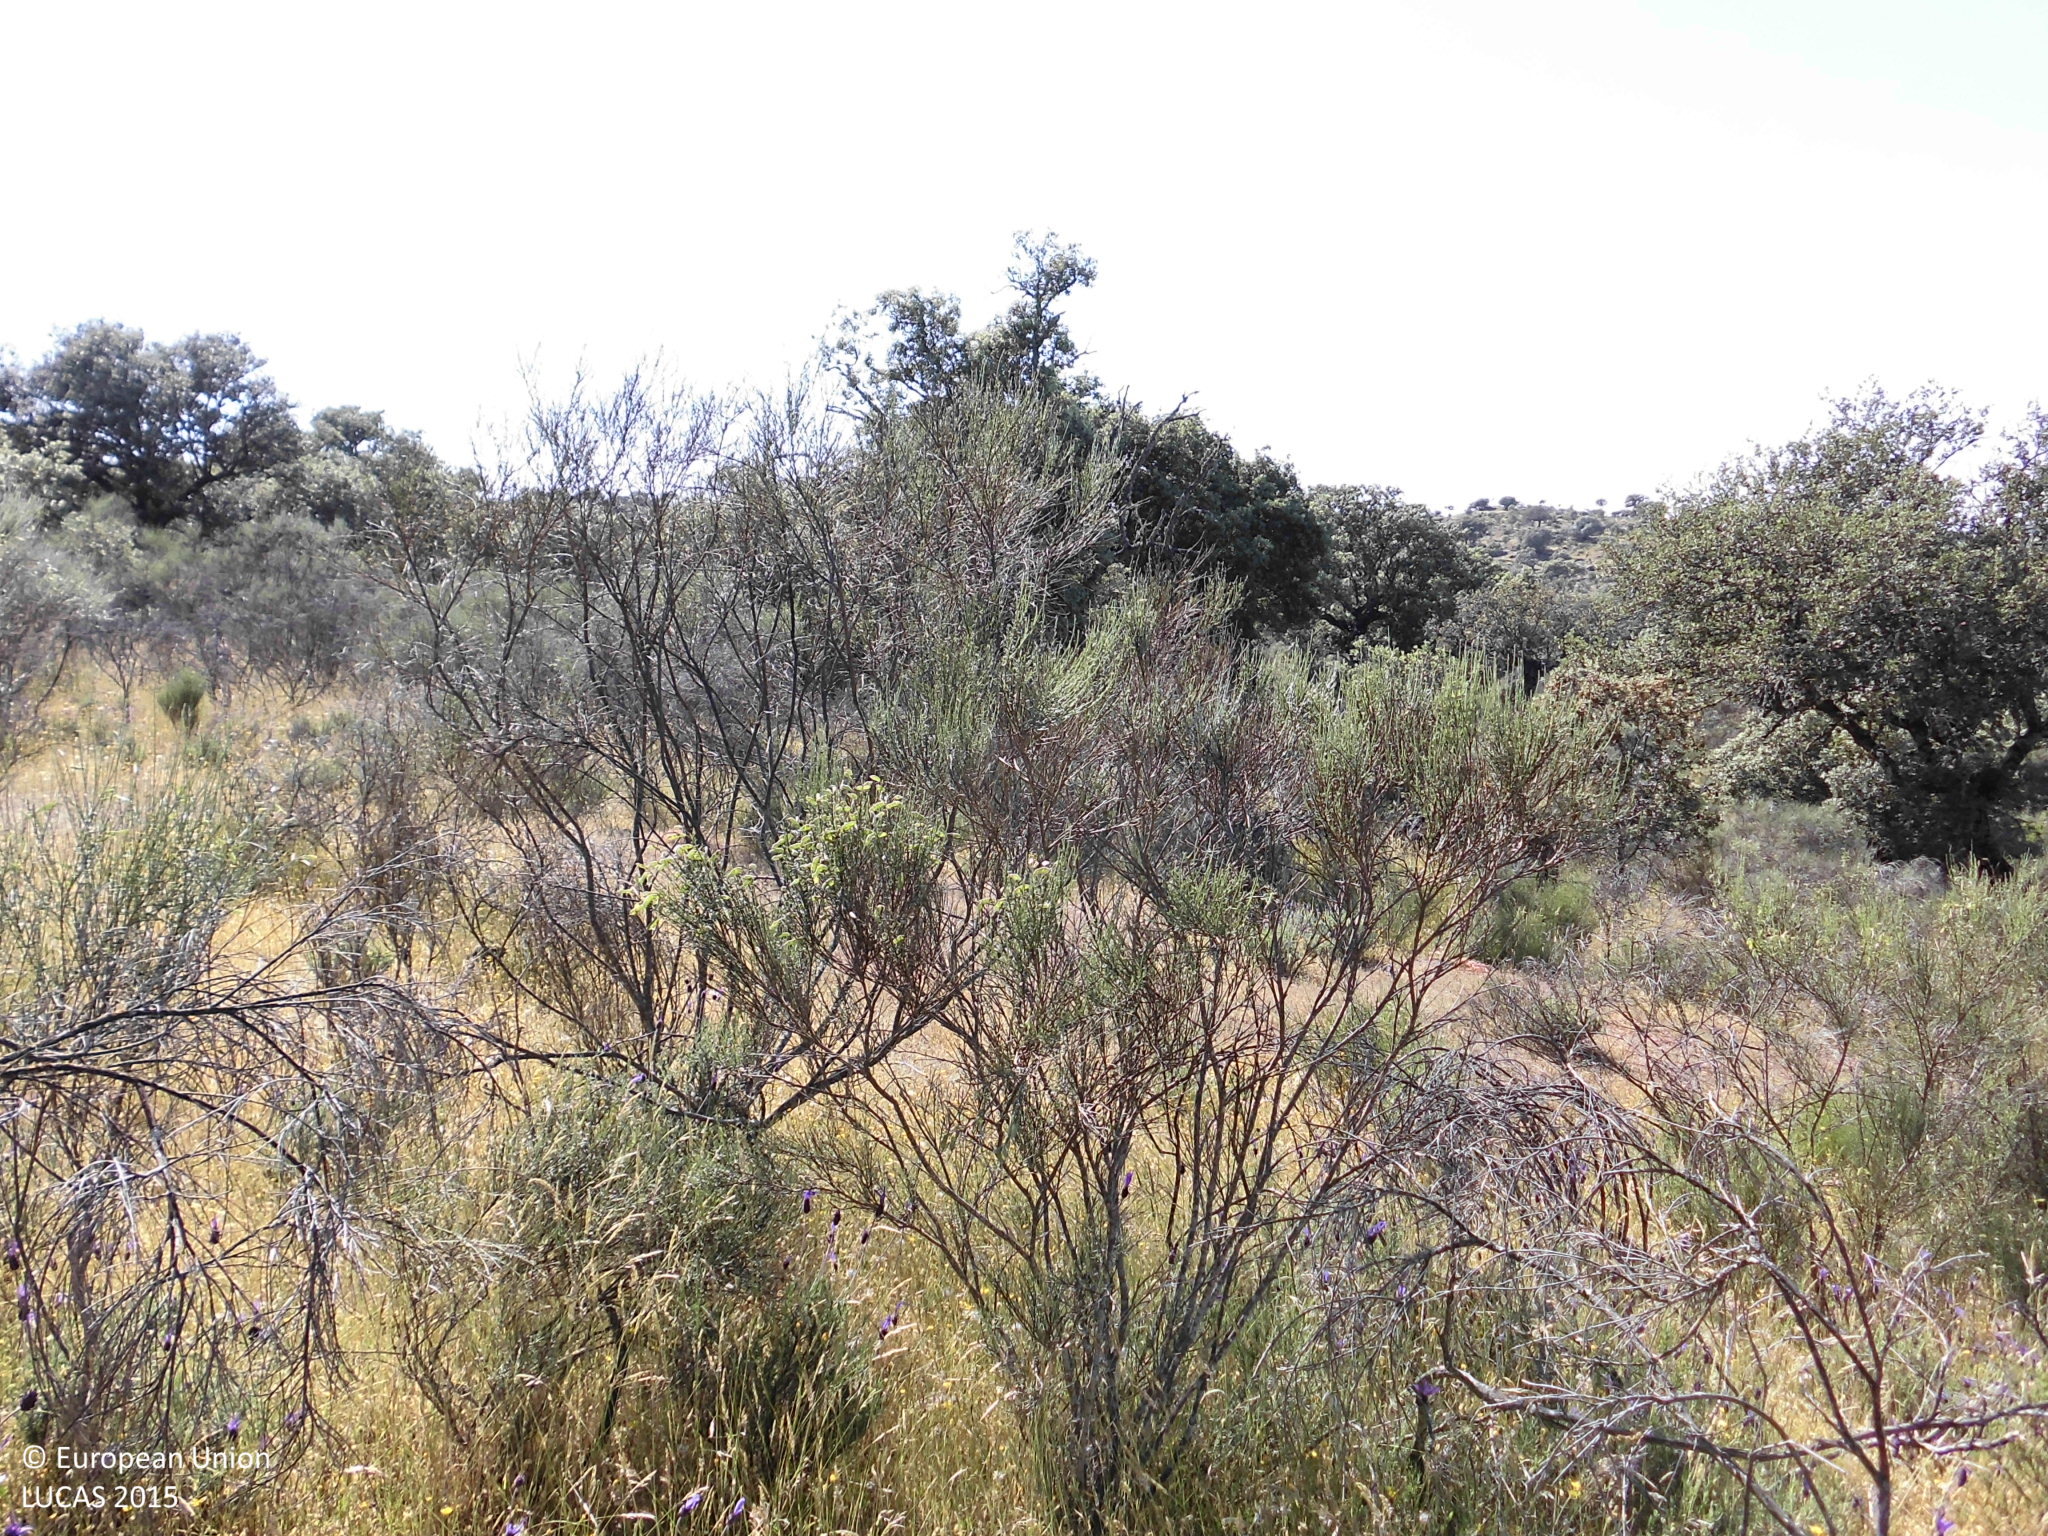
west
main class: Woodland
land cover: Broadleaved woodland
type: broadleaved evergreen forest
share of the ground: 25 - 50 %
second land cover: Shrubland without tree cover
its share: > 75 %
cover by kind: herbaceous plants 50 %, broadleaved forest trees 30 %, shrubs 20 %
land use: Forestry
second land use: Agriculture (excluding fallow land and kitchen gardens)
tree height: > 5 m
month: May
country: ES
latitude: 39.5339
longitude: -6.1078
